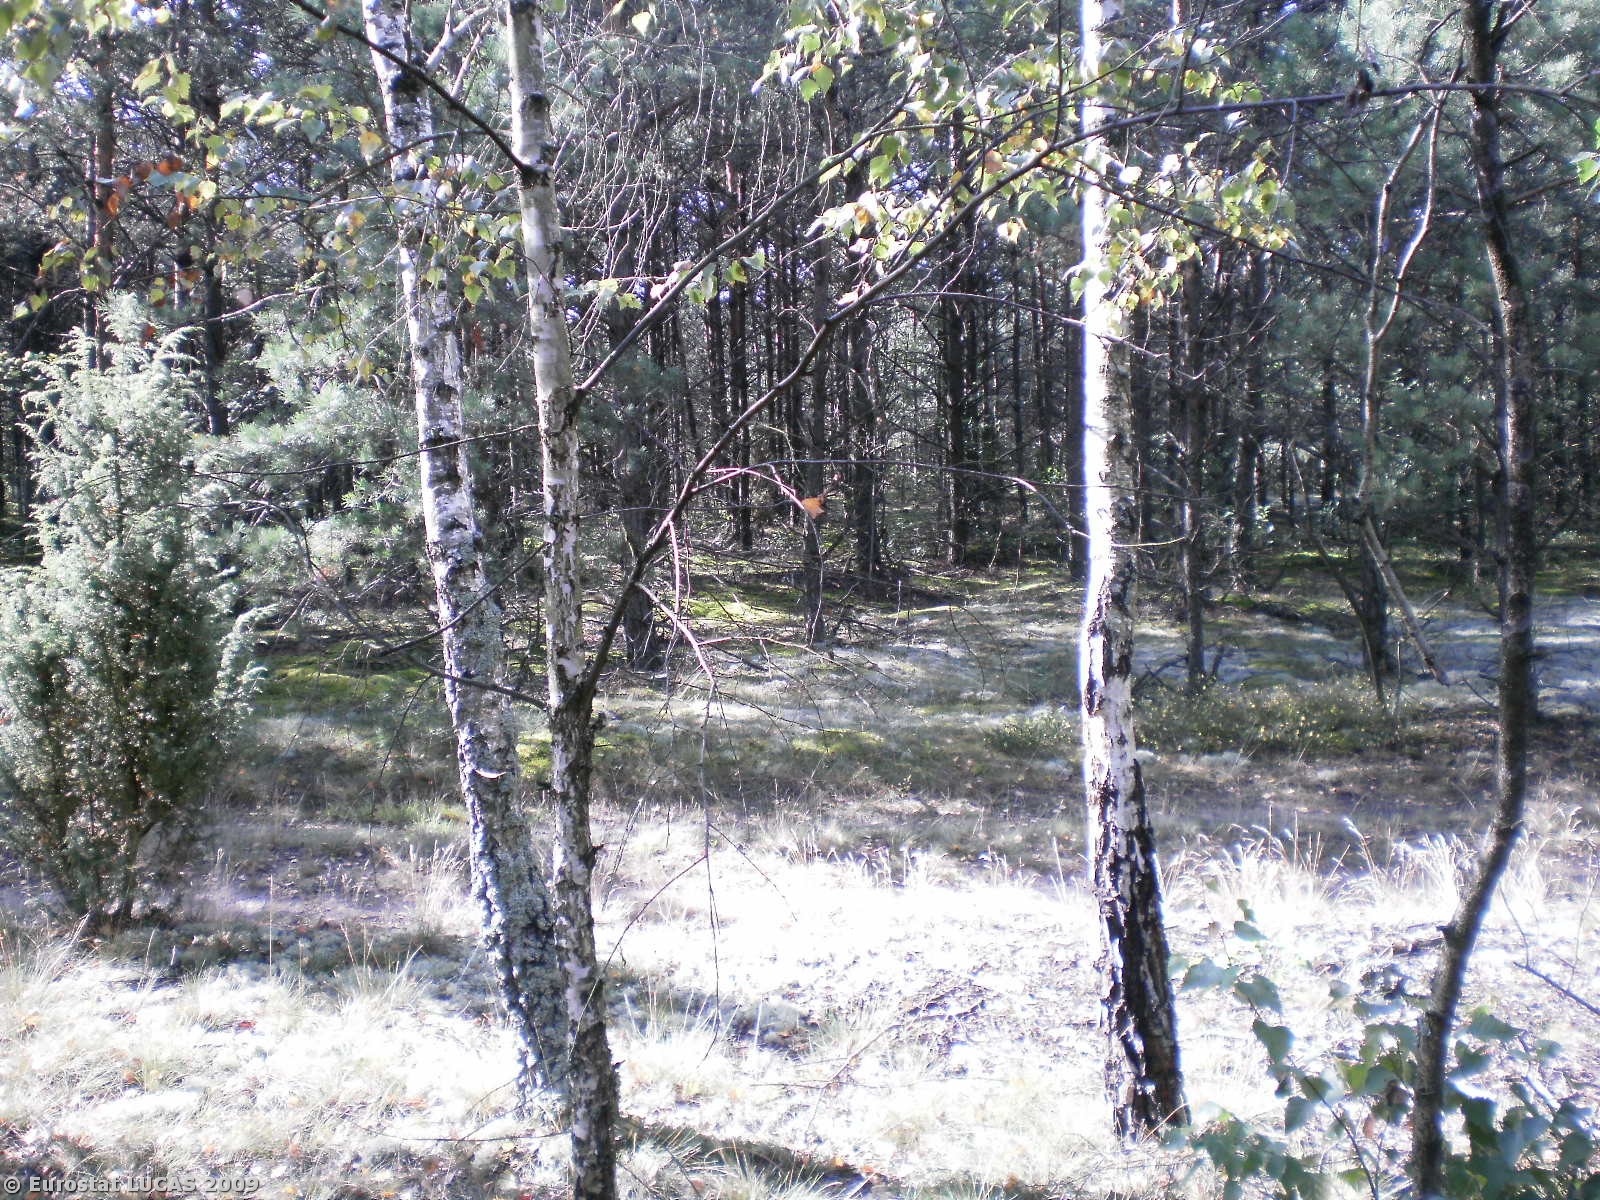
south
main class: Woodland
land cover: Coniferous woodland
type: hemiboreal forest and nemoral coniferous forest and mixed broadleaved-coniferous forest
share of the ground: > 75 %
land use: Forestry
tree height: > 5 m
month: August
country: PL
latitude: 53.1970
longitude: 21.5016
